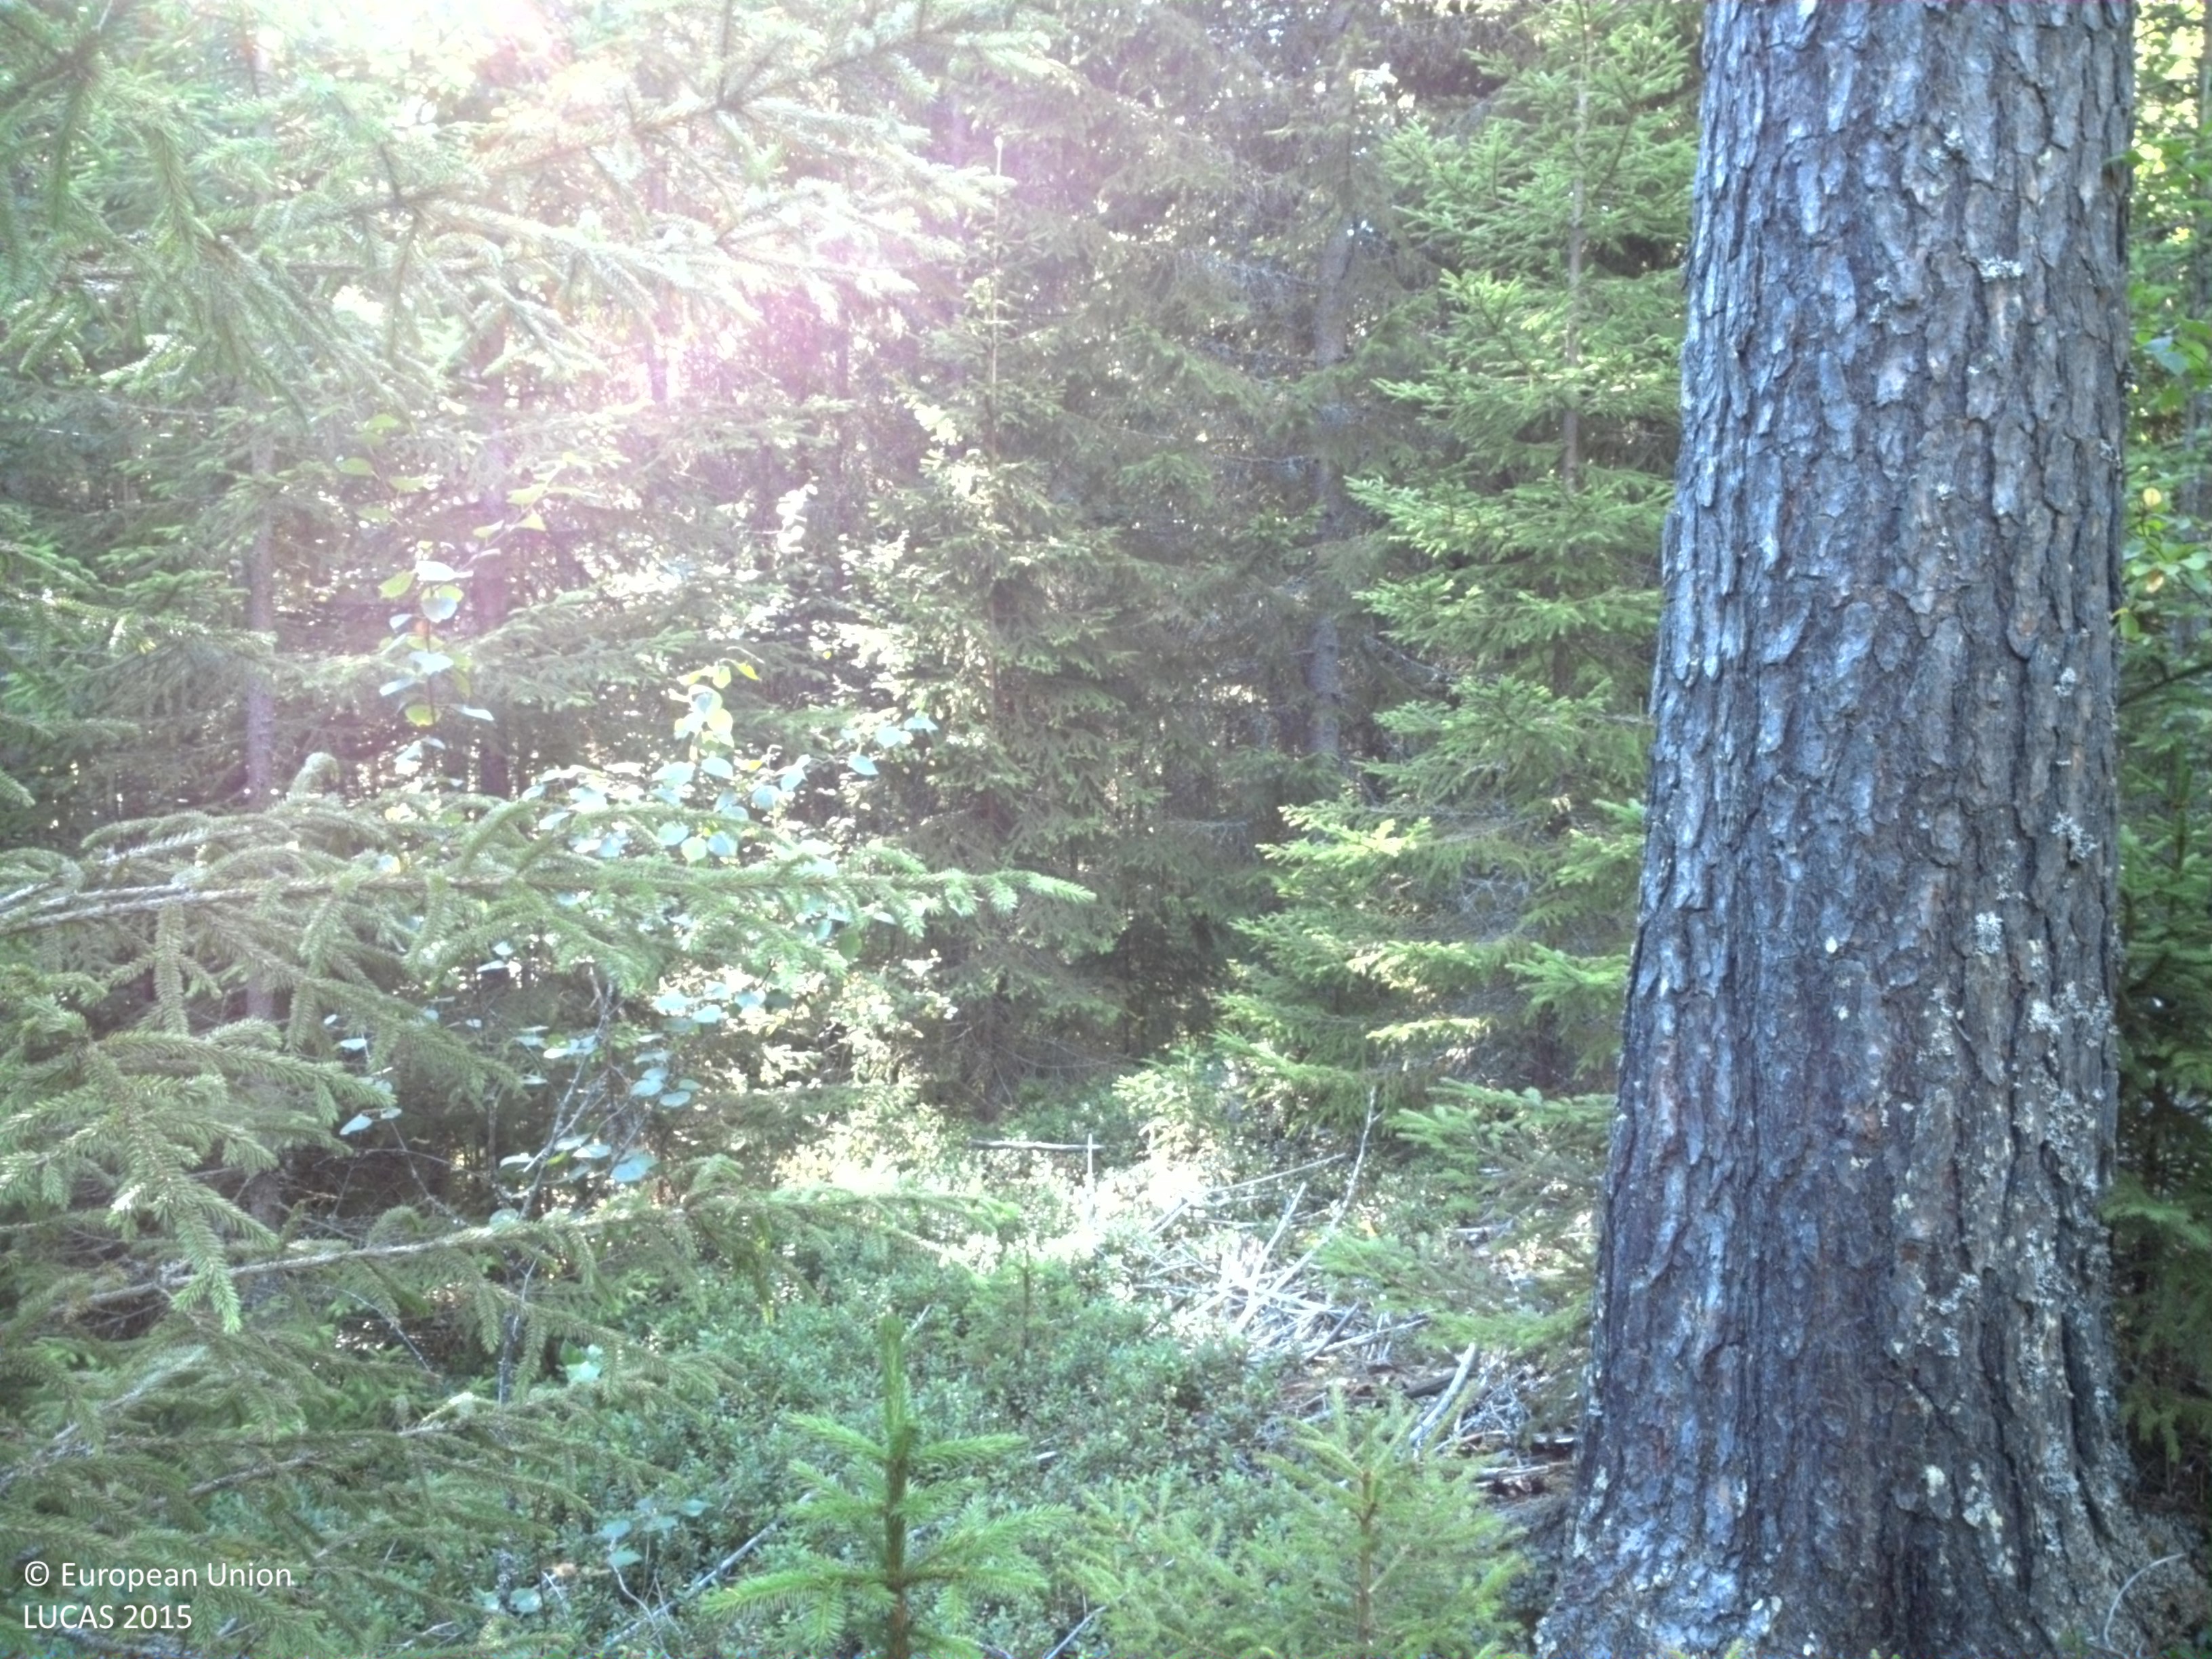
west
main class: Woodland
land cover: Spruce dominated mixed woodland
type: boreal forest
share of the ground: > 75 %
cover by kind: coniferous forest trees 50 %, broadleaved forest trees 35 %, shrubs 15 %
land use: Forestry
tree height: > 5 m
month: August
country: SE
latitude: 59.7774
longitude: 14.1404
